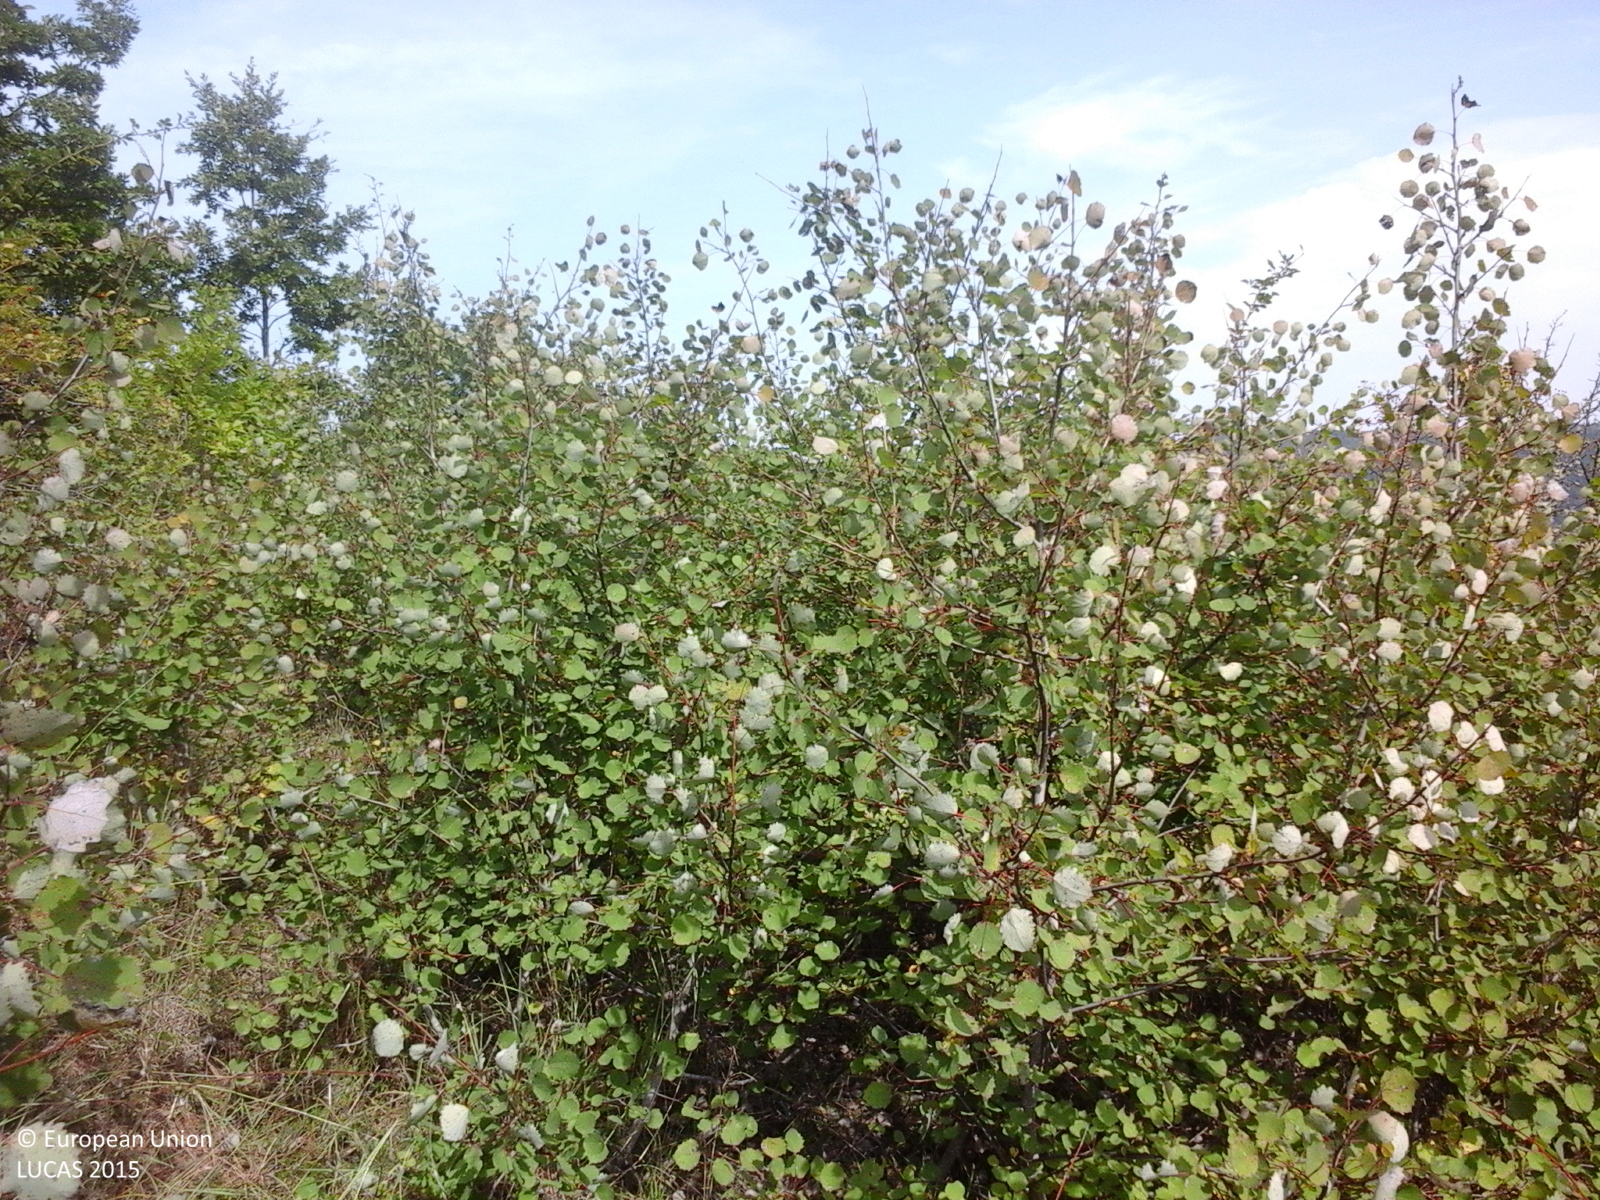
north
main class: Shrubland
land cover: Shrubland with sparse tree cover
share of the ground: > 75 %
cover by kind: herbaceous plants 55 %, shrubs 40 %, broadleaved forest trees 5 %
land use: Fallow land
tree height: < 5 m
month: September
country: RO
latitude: 47.0119
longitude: 23.1532
